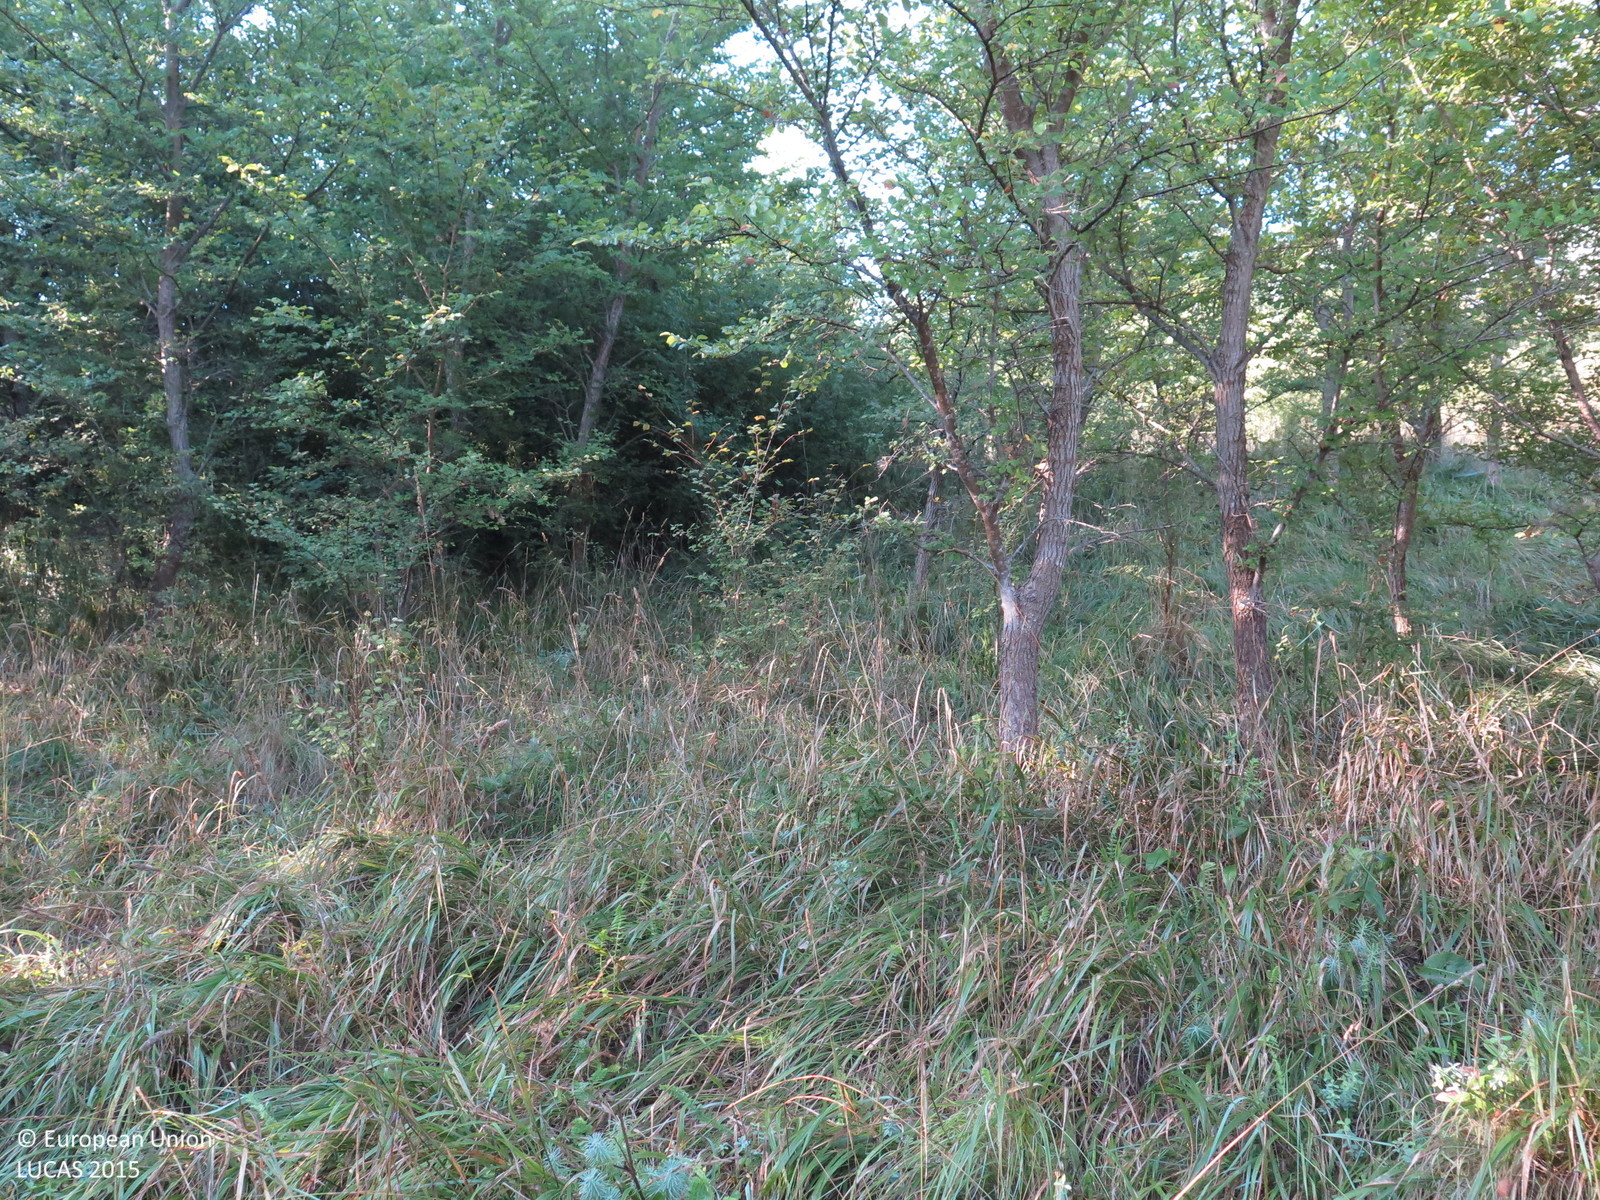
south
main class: Grassland
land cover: Grassland with sparse tree/shrub cover
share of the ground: > 75 %
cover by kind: herbaceous plants 85 %, shrubs 10 %, broadleaved forest trees 5 %
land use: Protection infrastructures
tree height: < 5 m
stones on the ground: 10 - 25 %
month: August
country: HR
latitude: 45.2207
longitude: 14.6685
